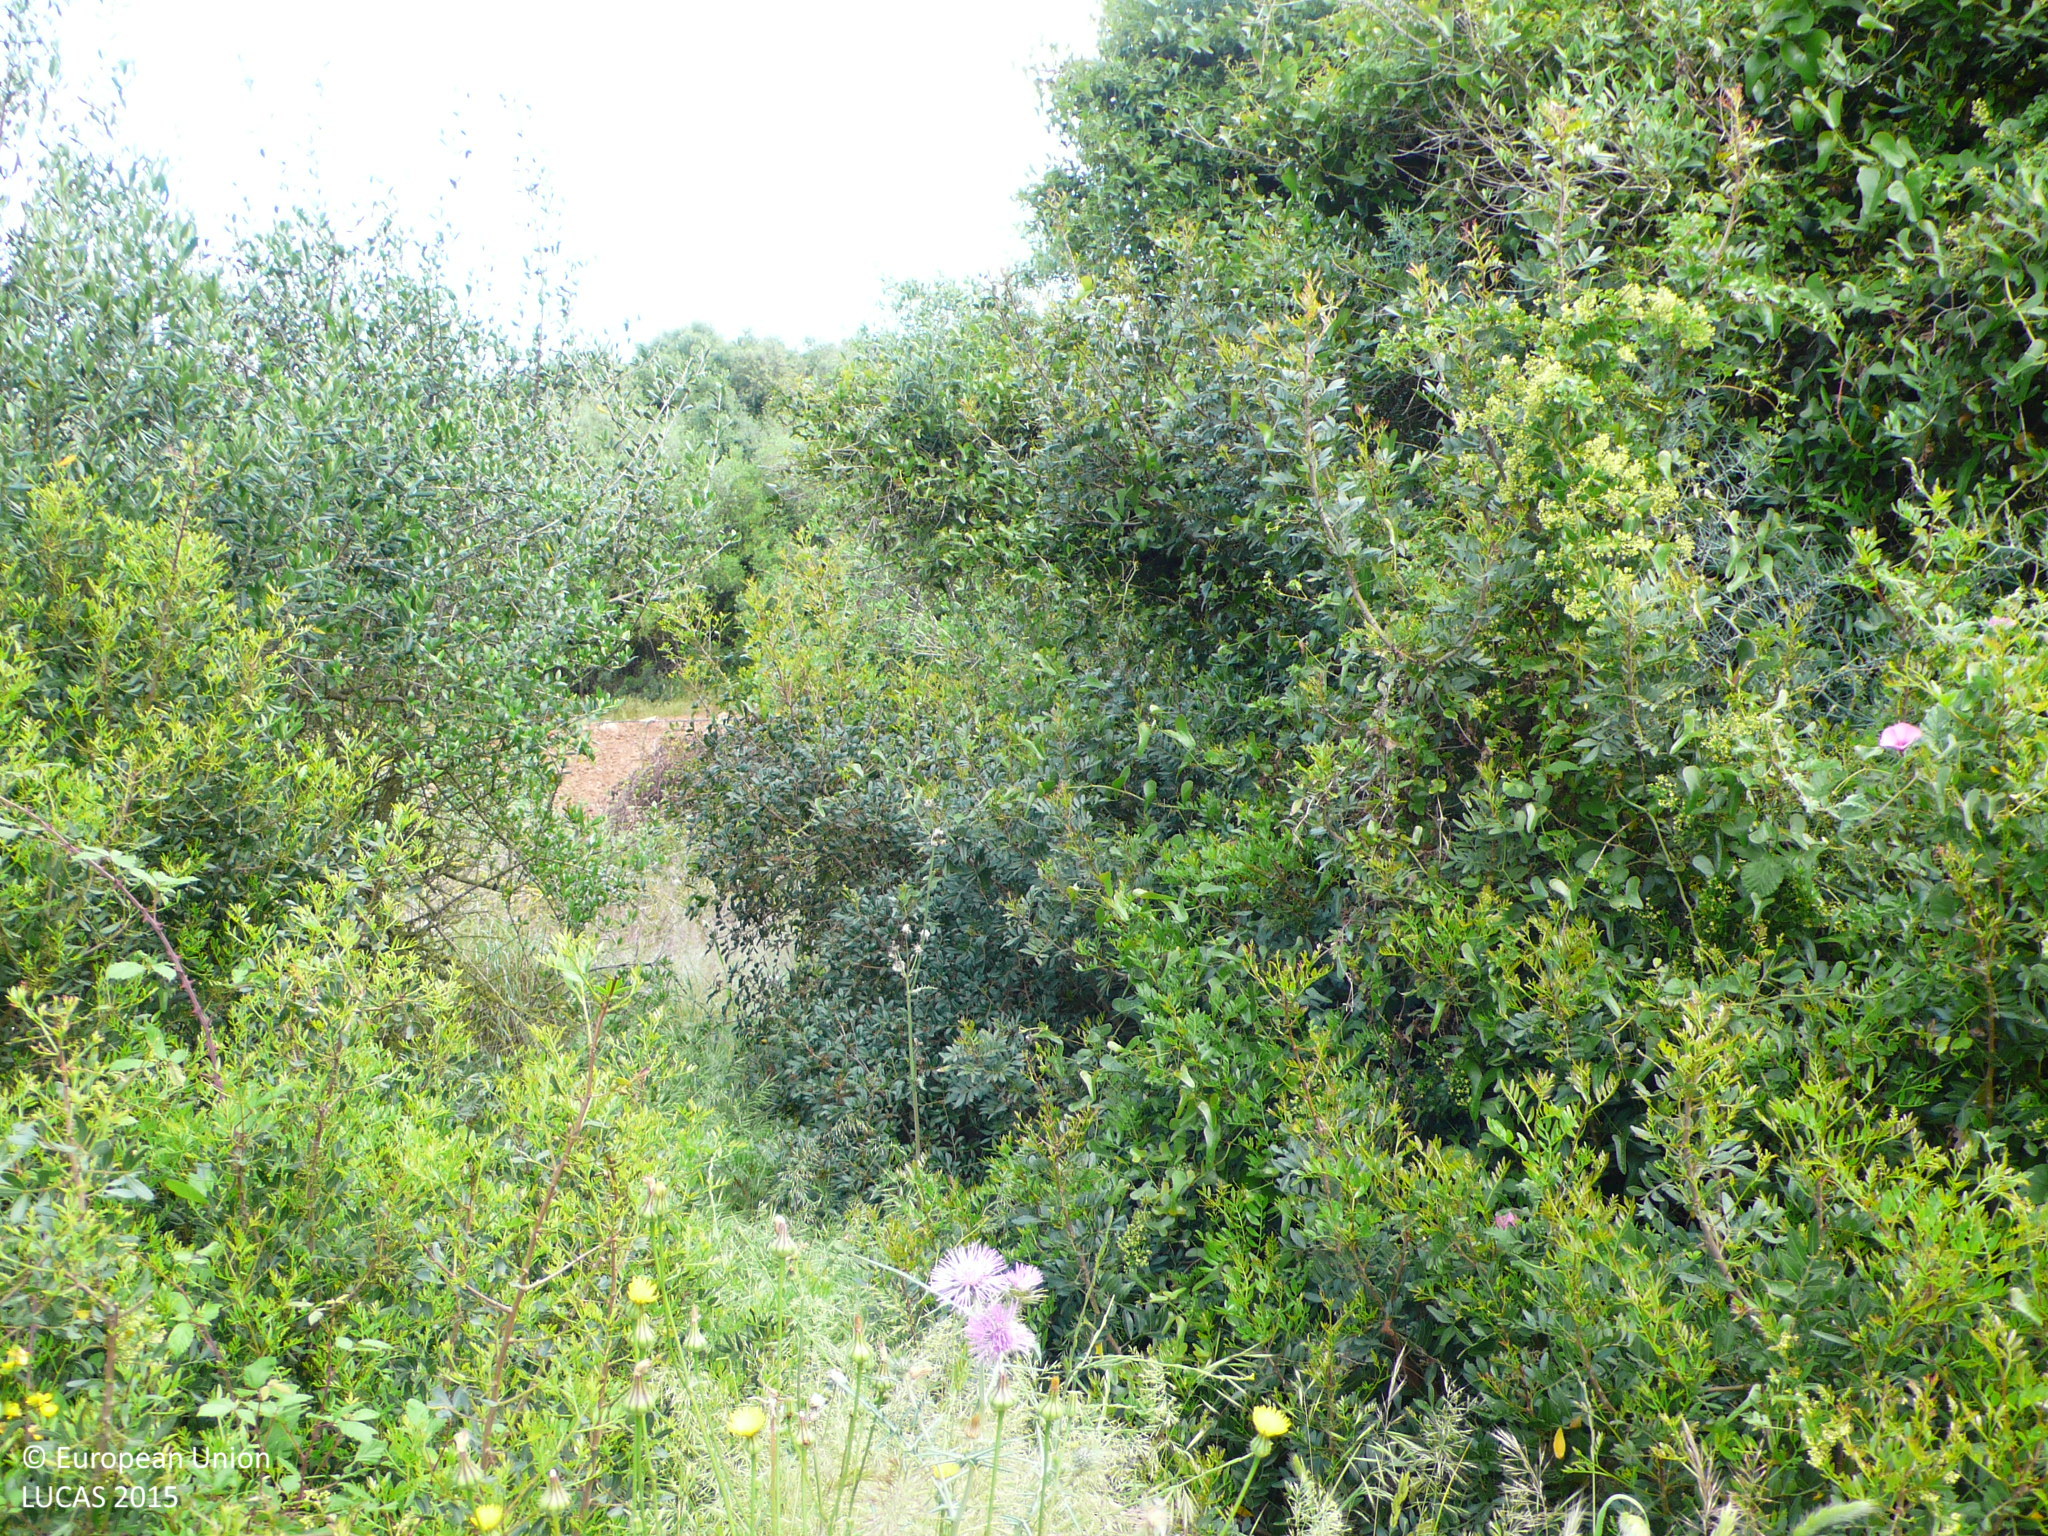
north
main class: Woodland
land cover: Broadleaved woodland
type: broadleaved evergreen forest
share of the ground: 25 - 50 %
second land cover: Grassland without tree/shrub cover
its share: 50 - 75 %
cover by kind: herbaceous plants 50 %, broadleaved forest trees 40 %, shrubs 10 %
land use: Forestry
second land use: Agriculture (excluding fallow land and kitchen gardens)
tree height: > 5 m
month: May
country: ES
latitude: 39.9593
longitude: 4.0442
